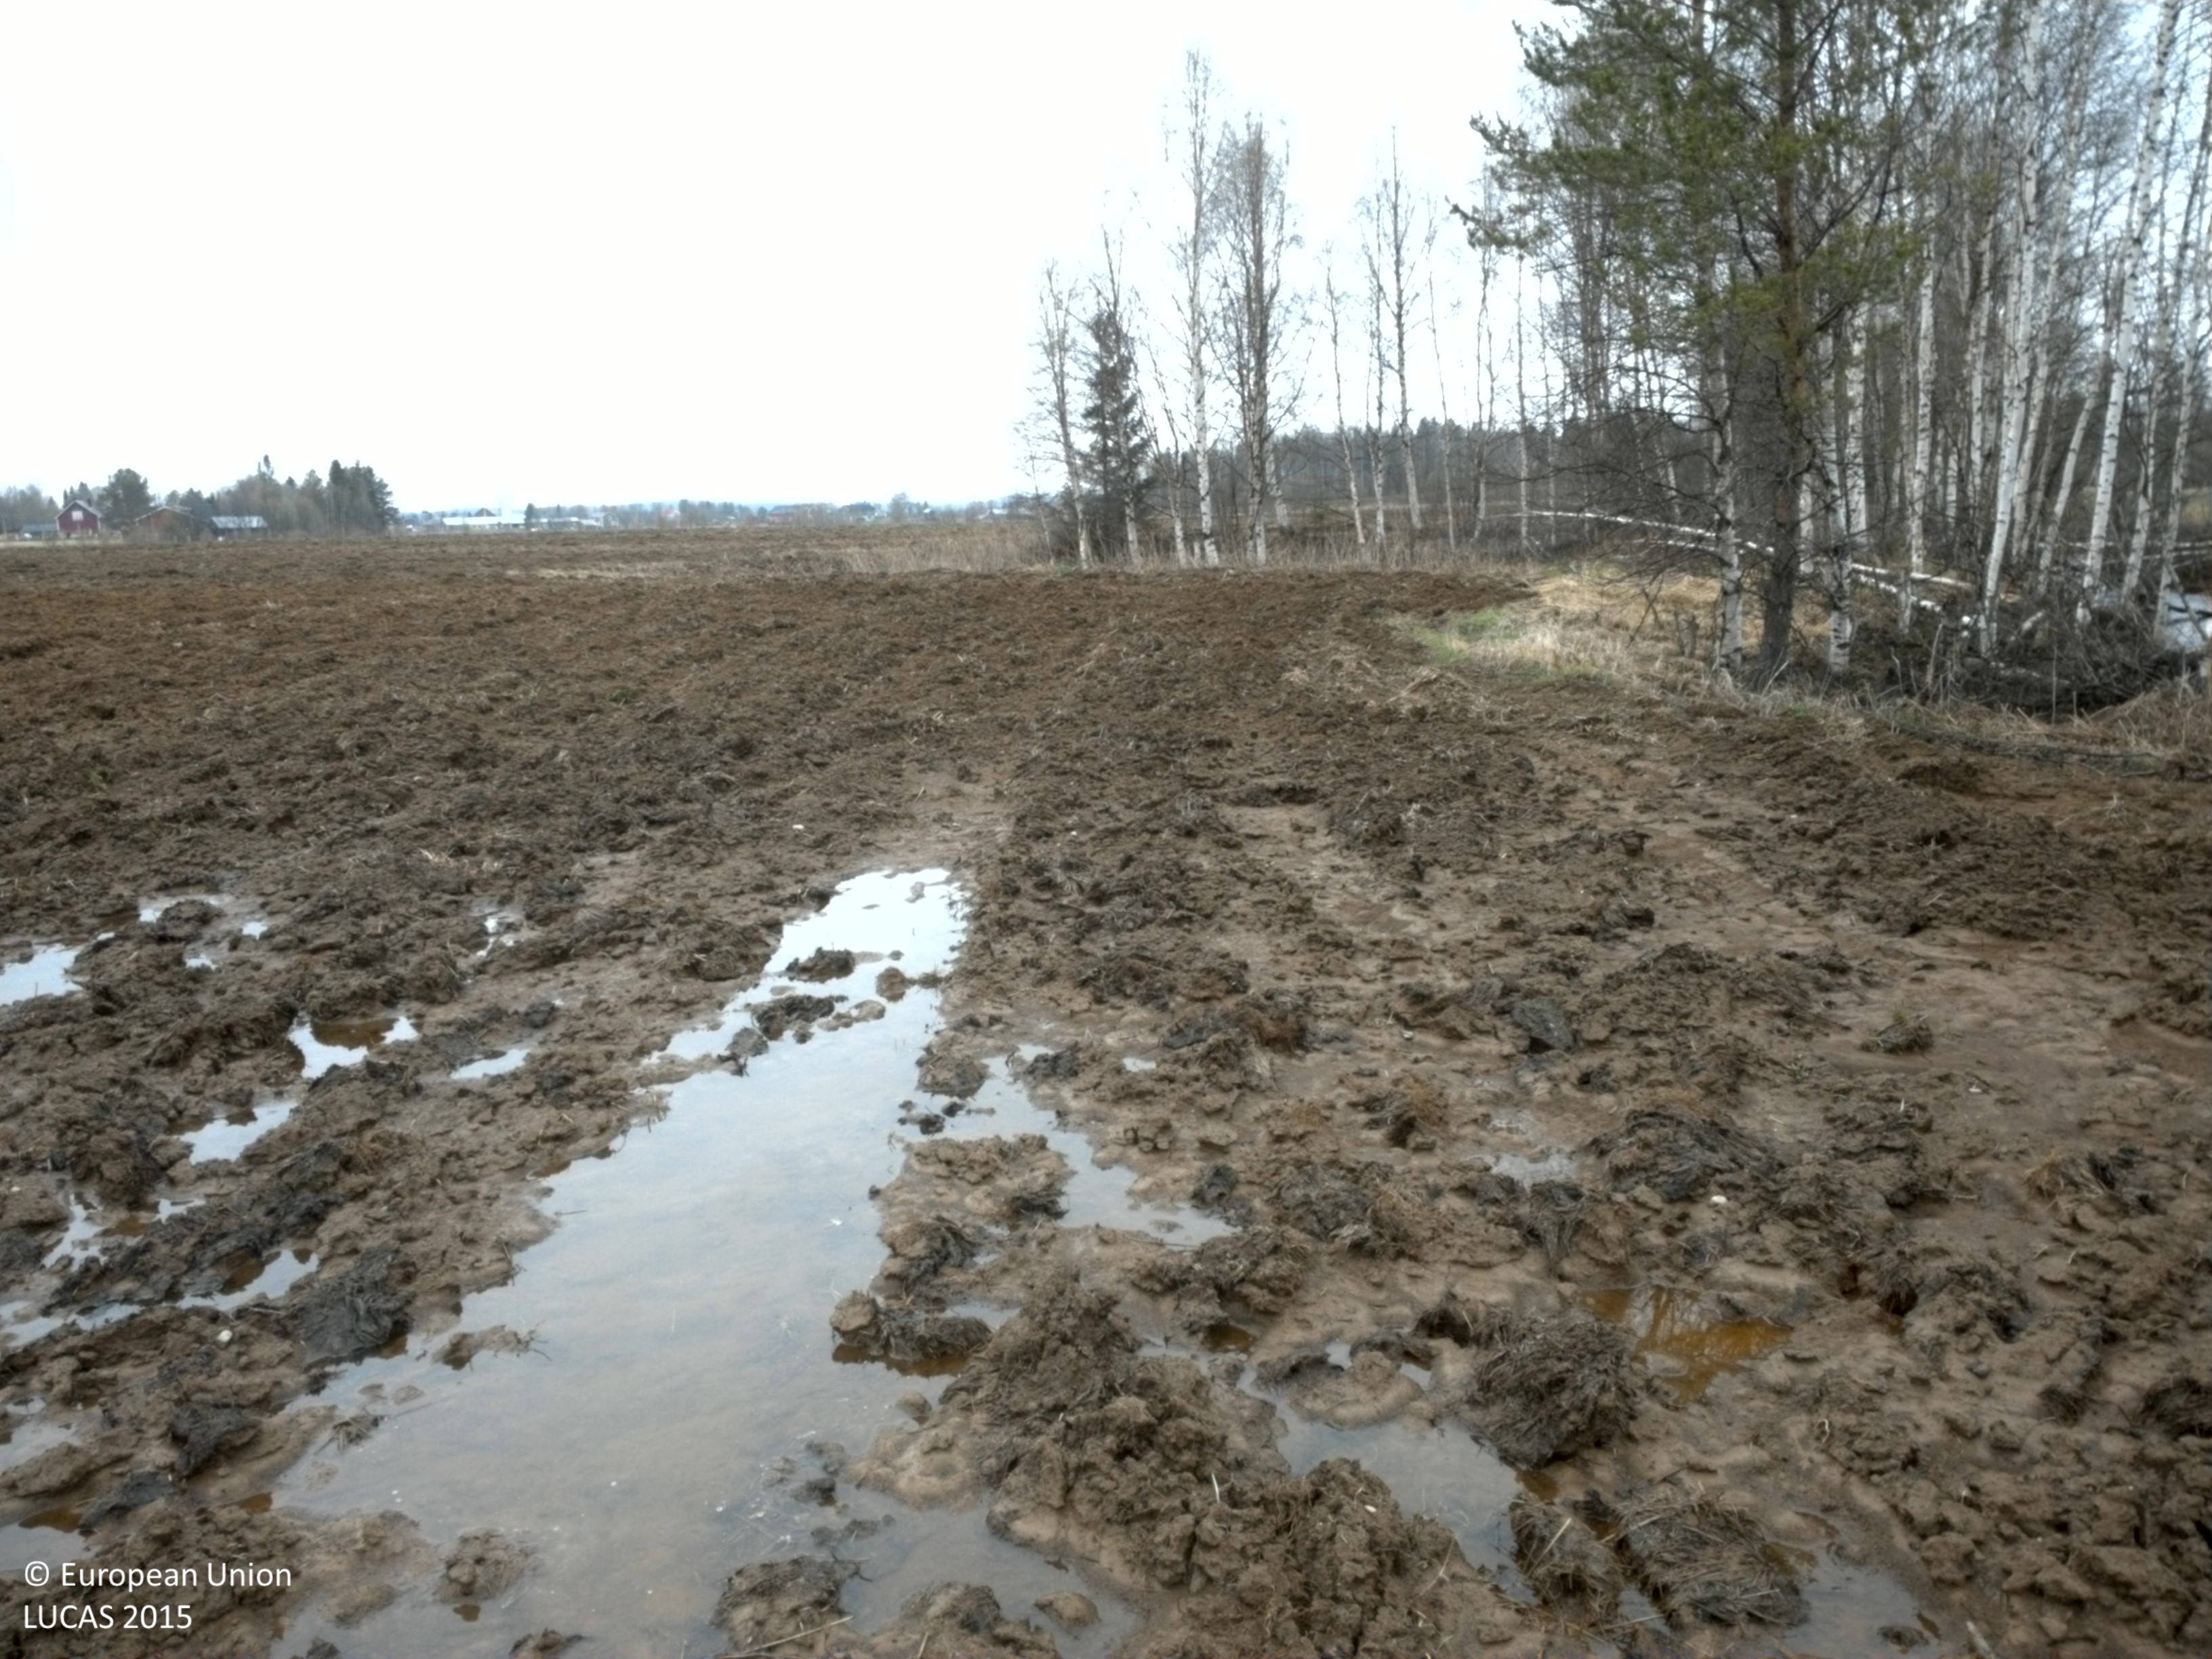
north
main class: Cropland
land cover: Temporary grasslands
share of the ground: > 75 %
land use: Agriculture (excluding fallow land and kitchen gardens)
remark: Tilled/Sowed
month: May
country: SE
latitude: 65.8613
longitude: 23.0254
